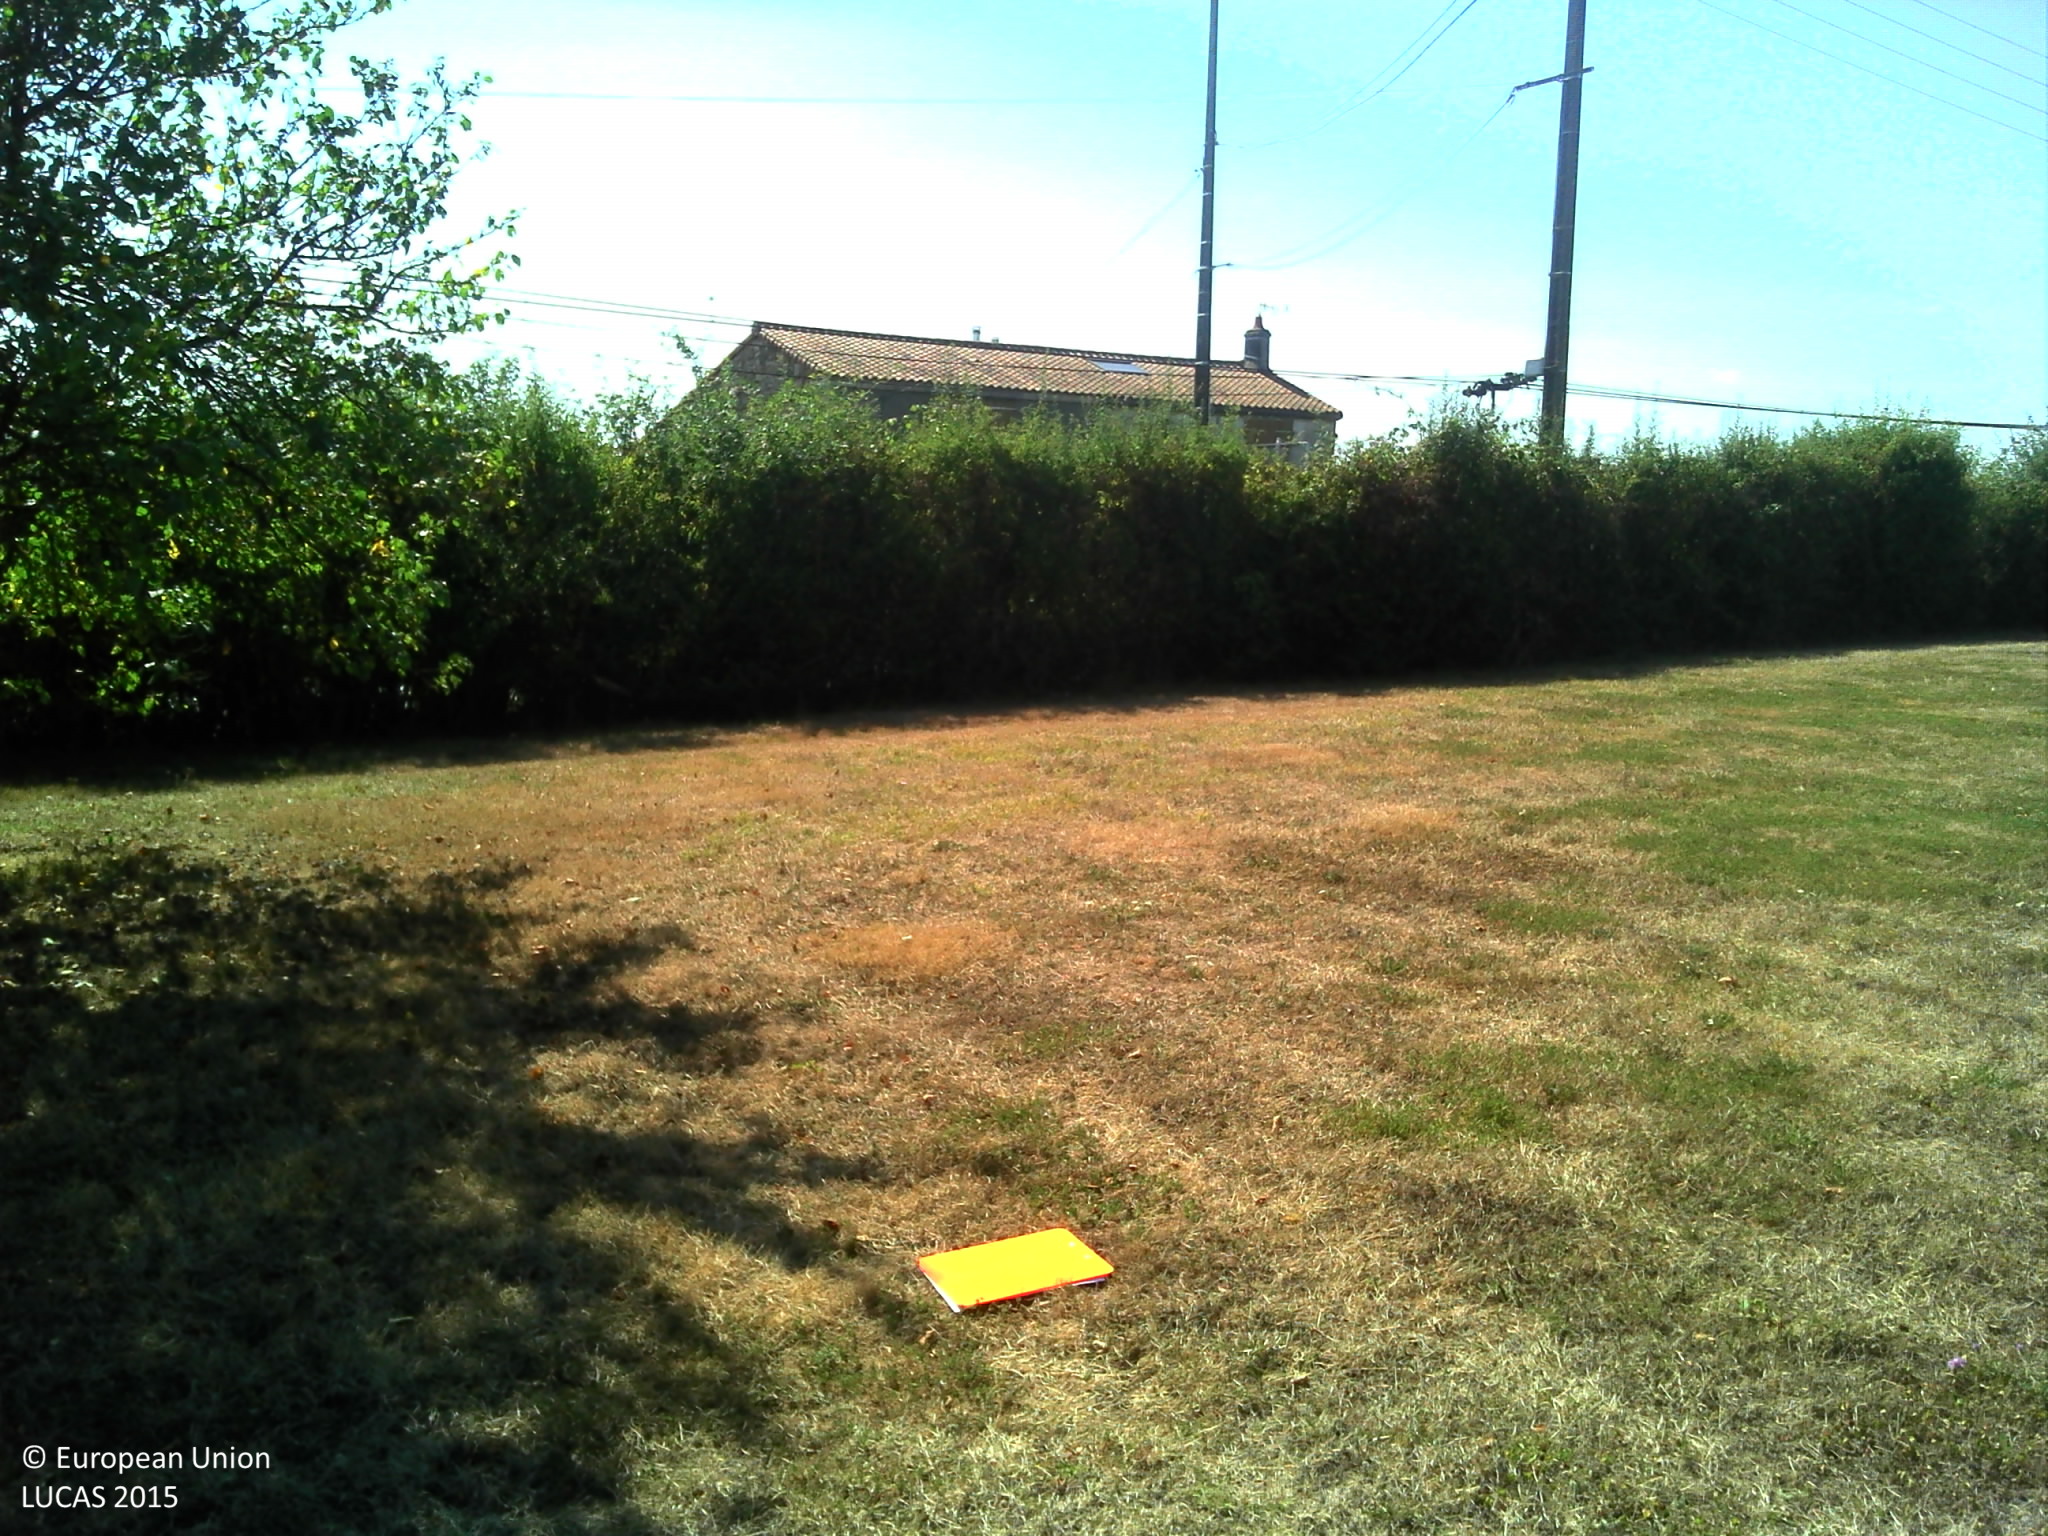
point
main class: Grassland
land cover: Grassland with sparse tree/shrub cover
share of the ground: > 75 %
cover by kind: herbaceous plants 90 %, broadleaved forest trees 5 %, shrubs 5 %
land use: Residential
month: August
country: FR
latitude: 46.7532
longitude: -1.0962
